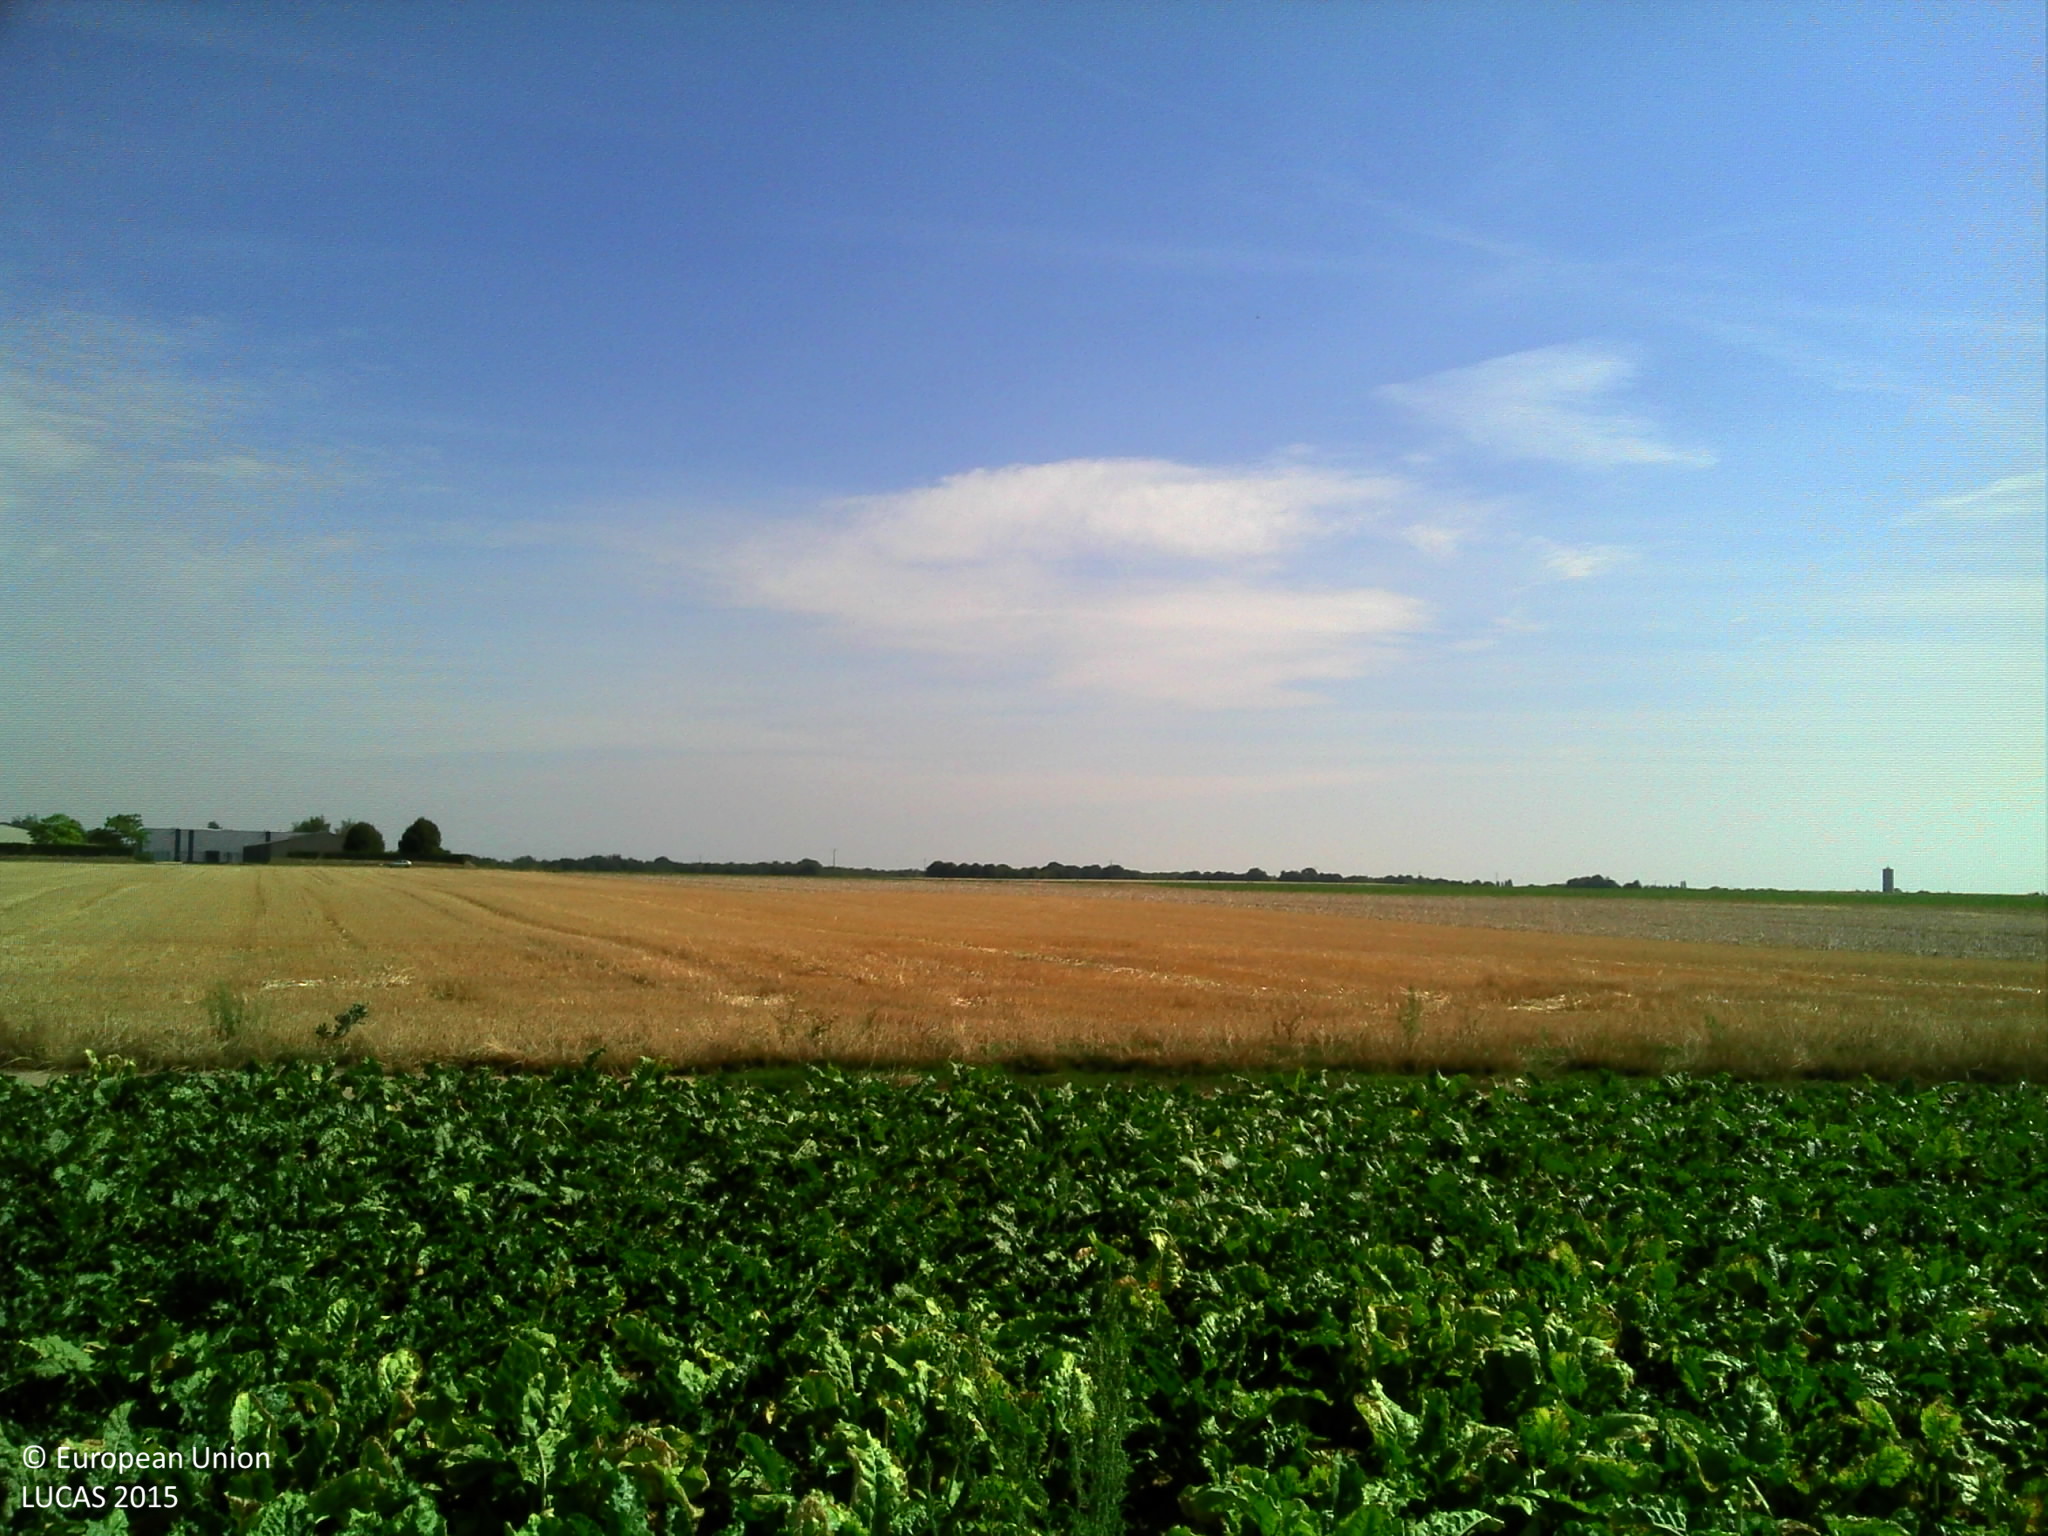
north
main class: Cropland
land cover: Sugar beet
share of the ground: > 75 %
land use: Agriculture (excluding fallow land and kitchen gardens)
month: August
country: FR
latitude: 48.3368
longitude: 2.6110
